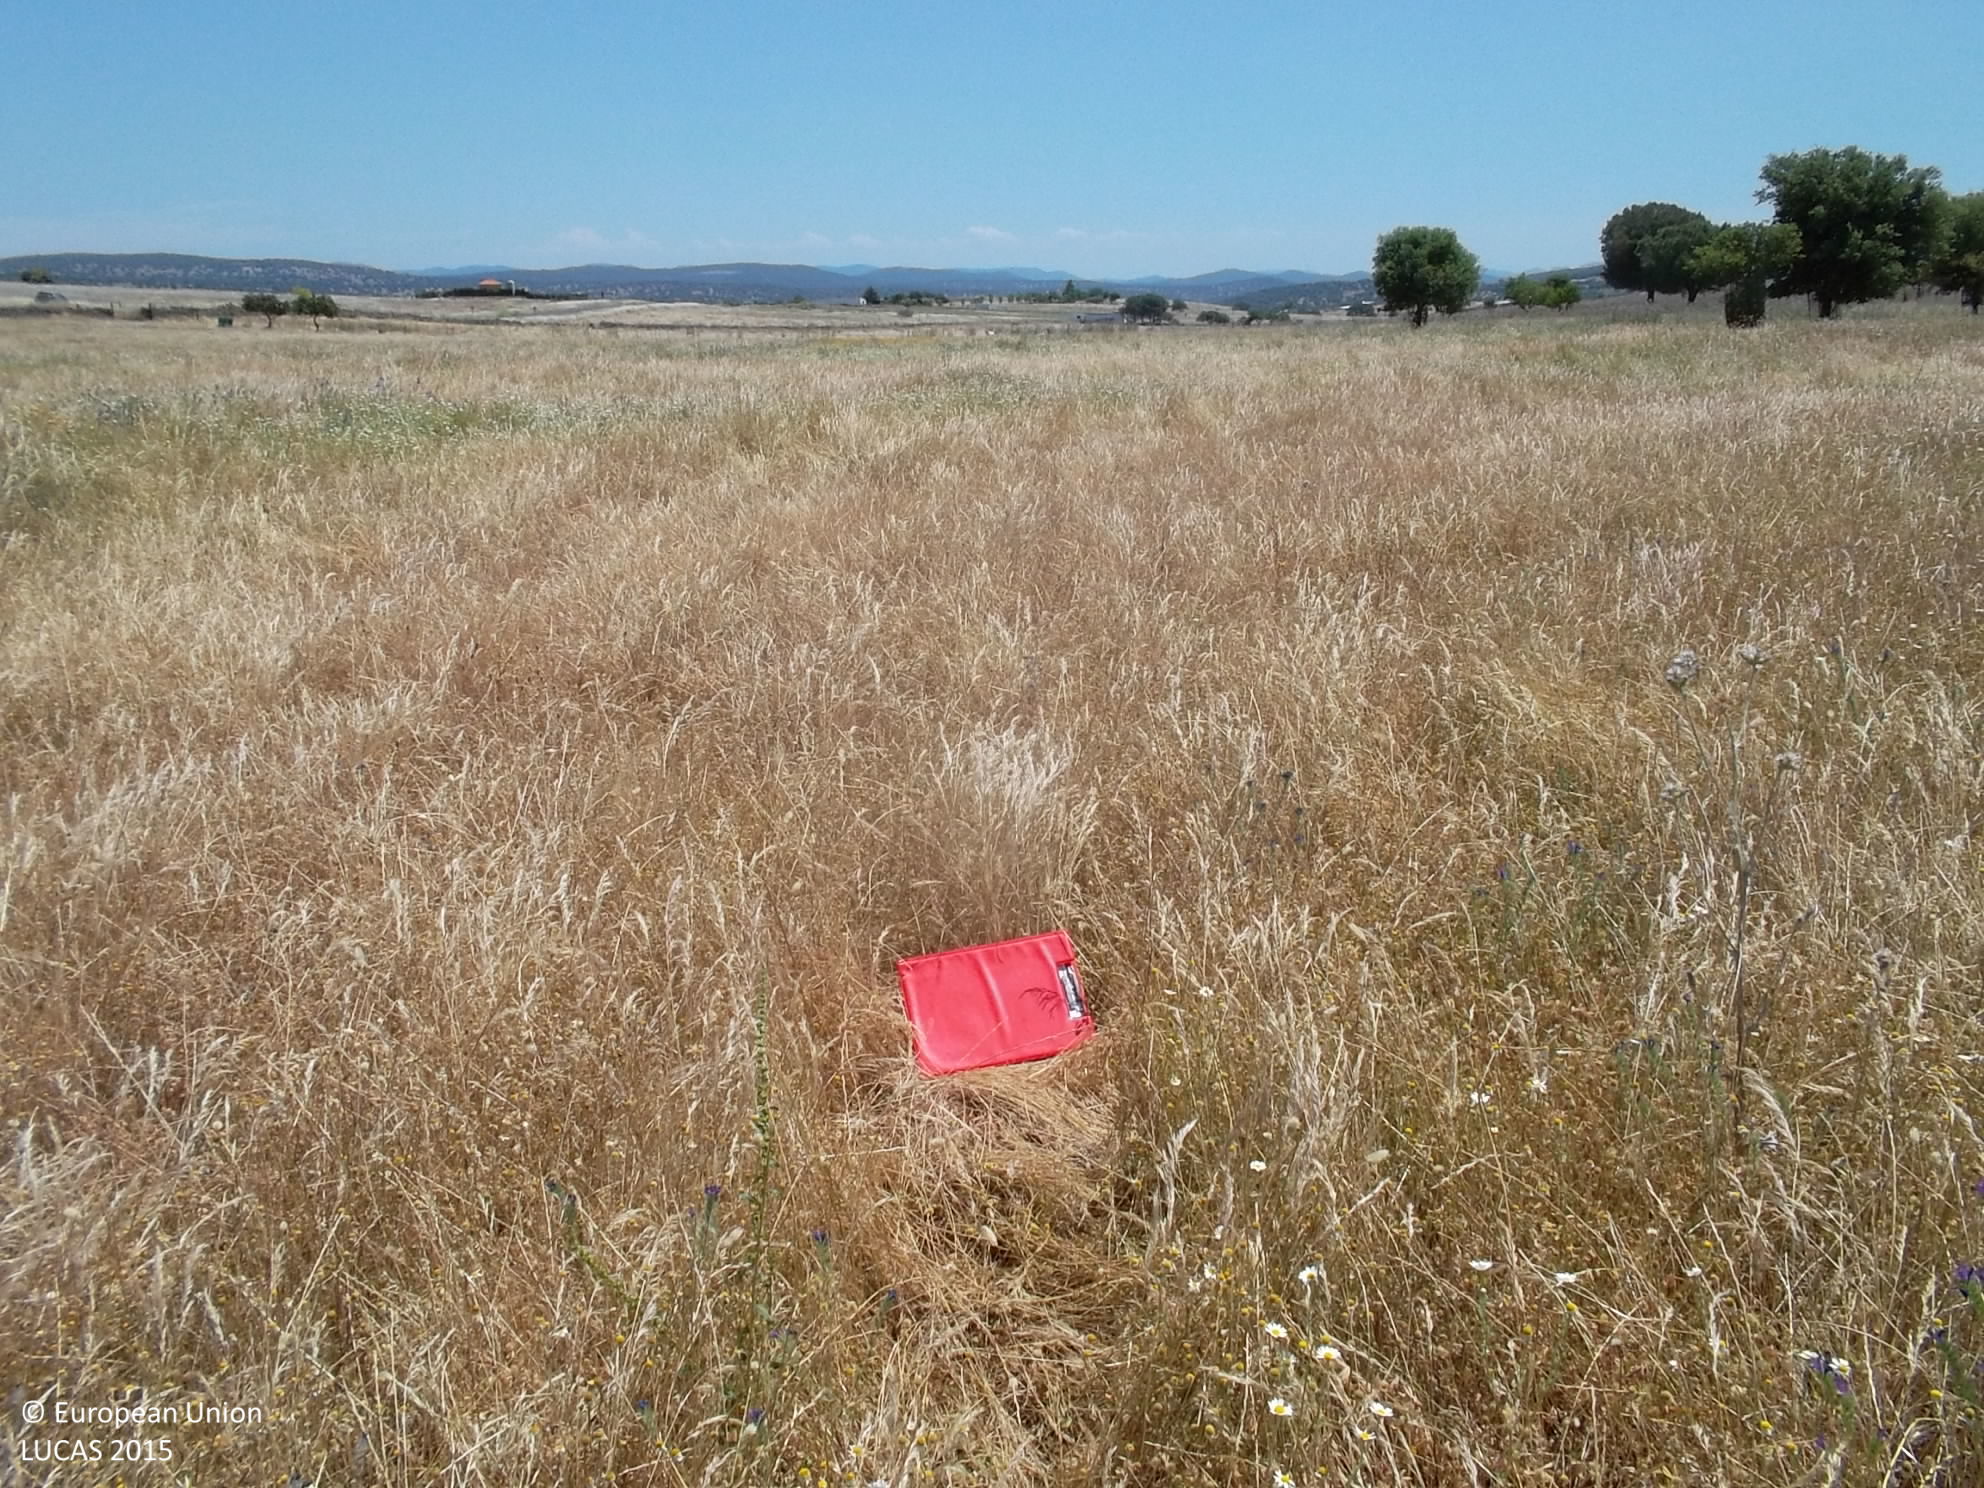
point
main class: Grassland
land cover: Spontaneously vegetated surfaces
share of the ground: > 75 %
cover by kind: herbaceous plants 100 %
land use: Agriculture (excluding fallow land and kitchen gardens)
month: May
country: ES
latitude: 38.7997
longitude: -4.8491
